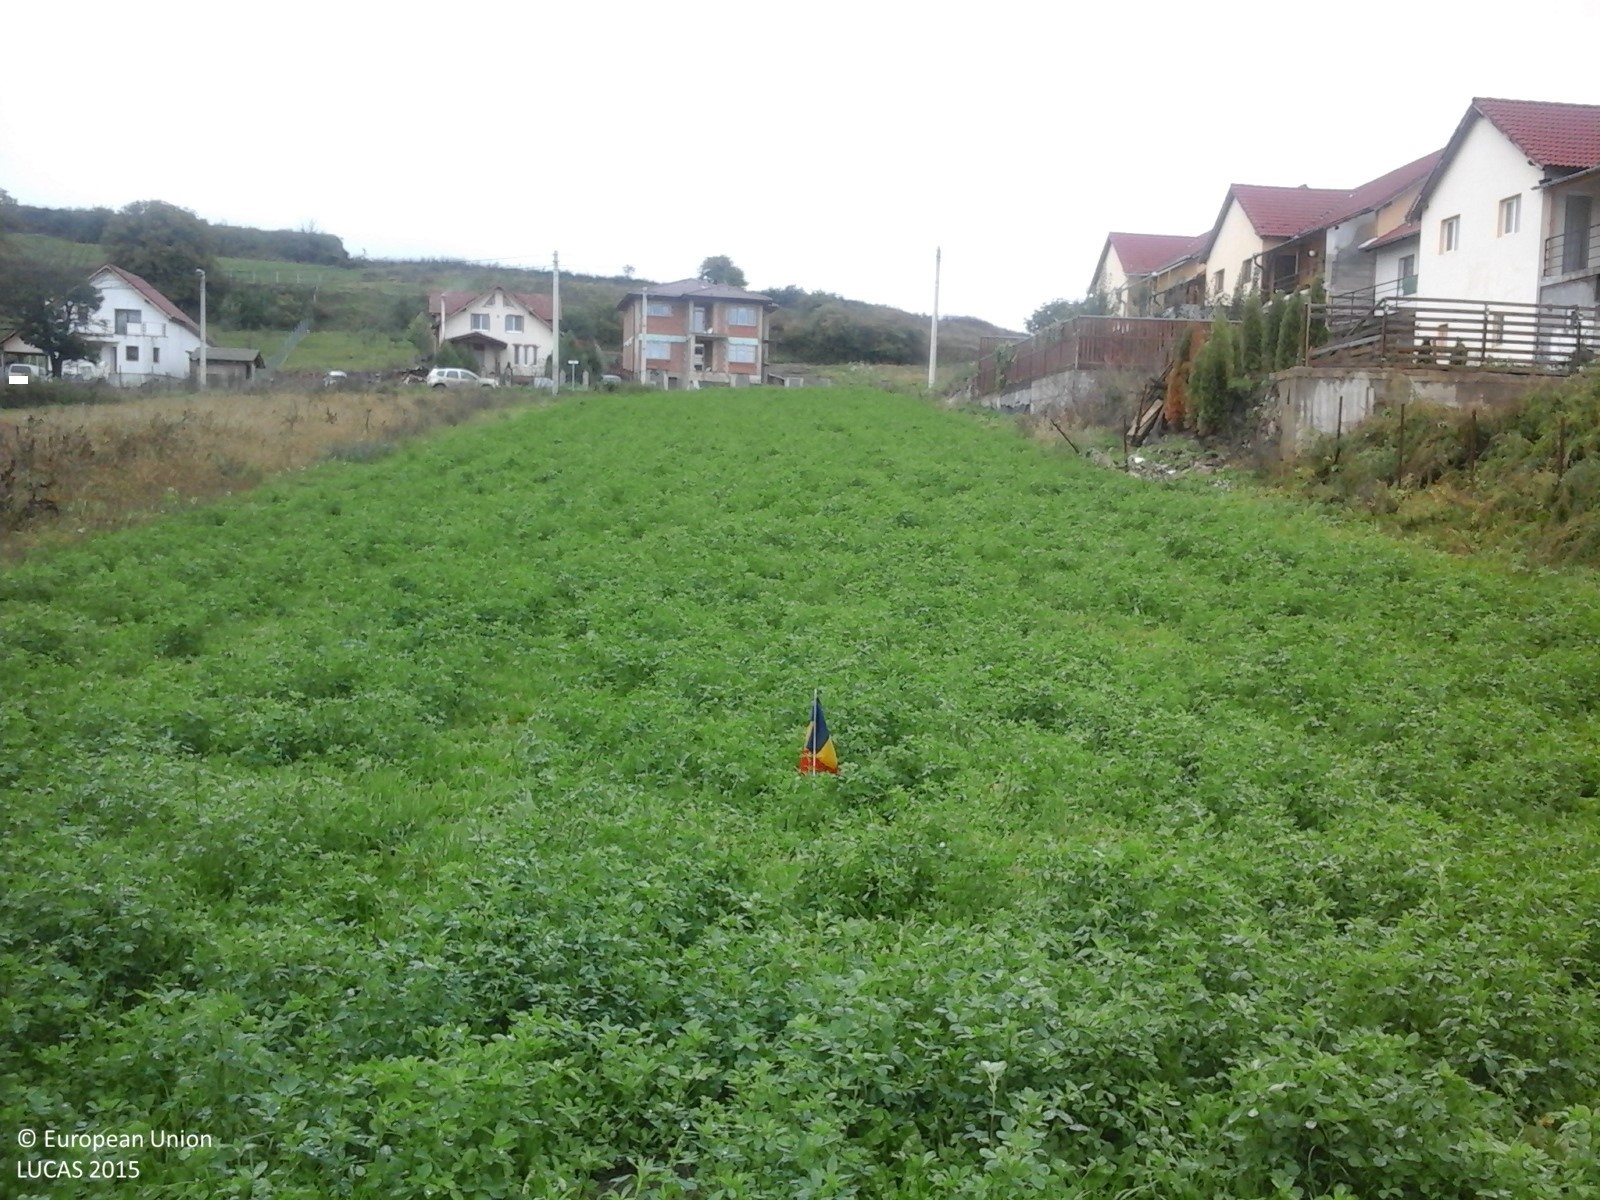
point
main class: Cropland
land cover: Lucerne
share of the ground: > 75 %
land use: Agriculture (excluding fallow land and kitchen gardens)
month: October
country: RO
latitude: 45.8435
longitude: 24.1489
